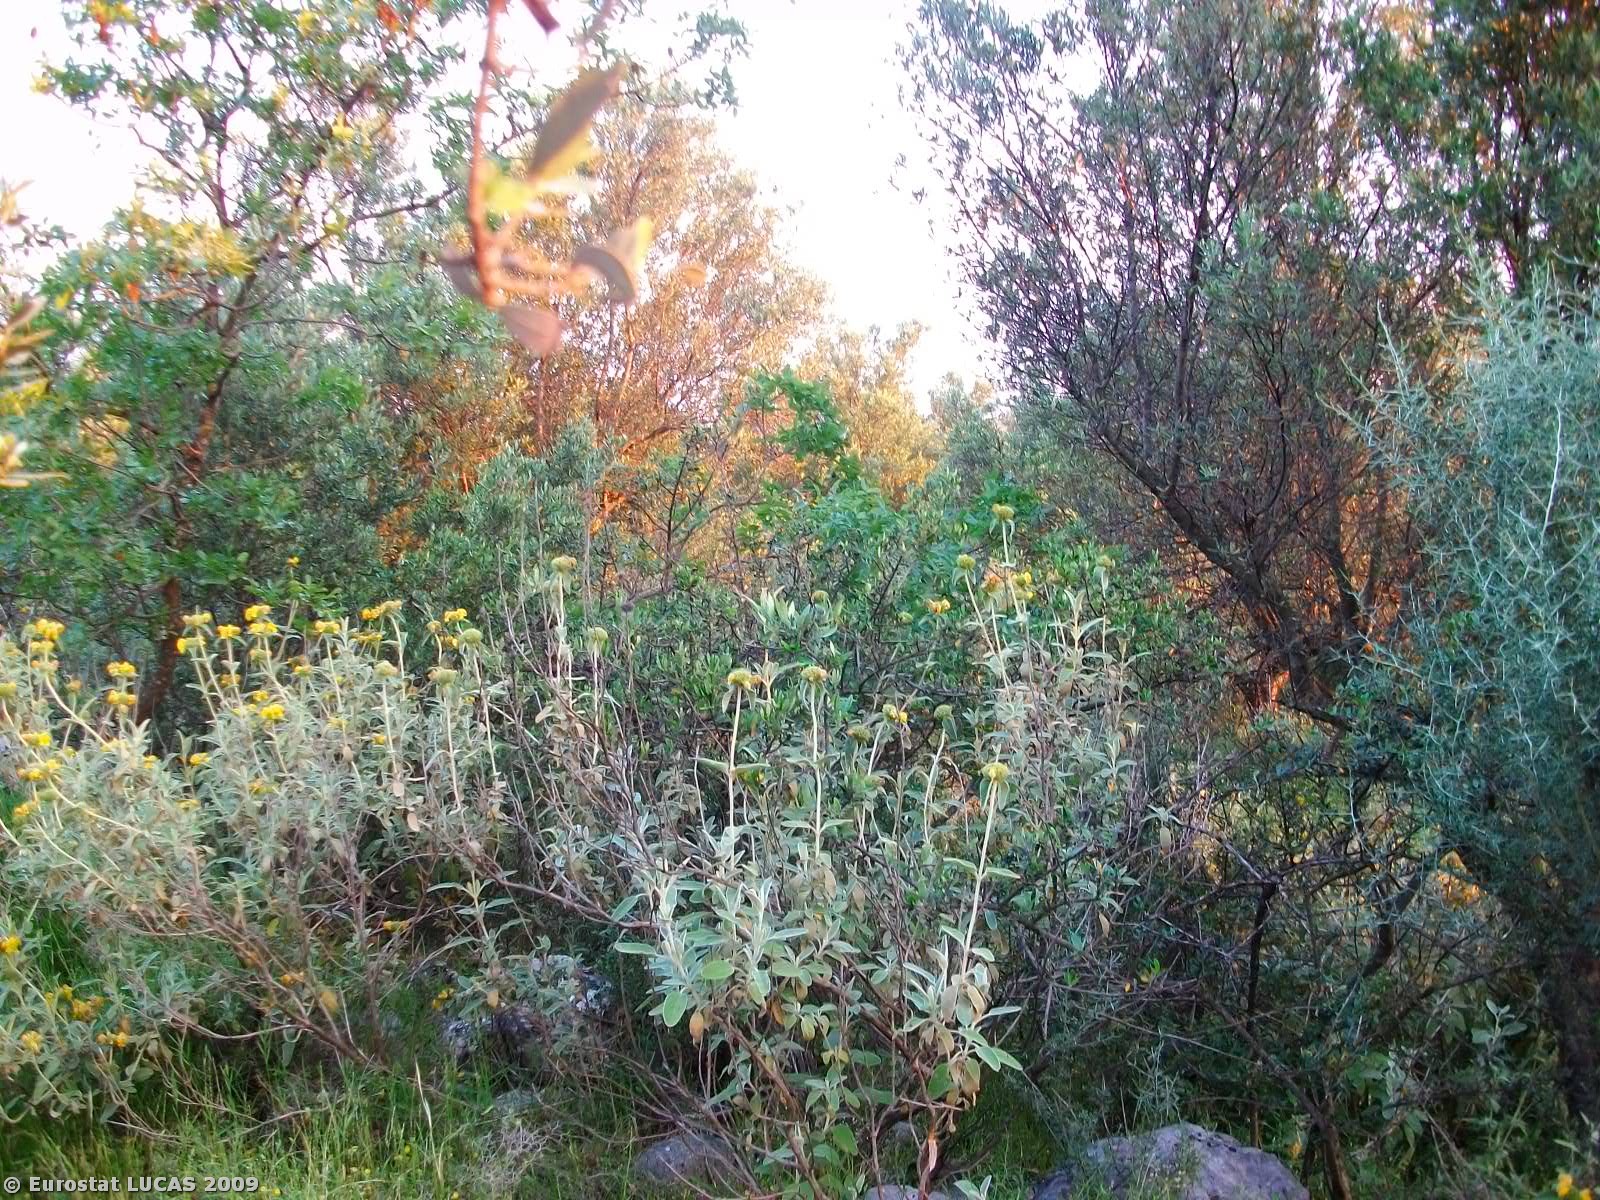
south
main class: Cropland
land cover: Olive groves
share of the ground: 50 - 75 %
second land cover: Grassland with sparse tree/shrub cover
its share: 50 - 75 %
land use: Agriculture (excluding fallow land and kitchen gardens)
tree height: < 5 m
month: May
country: GR
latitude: 37.1838
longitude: 22.0190
